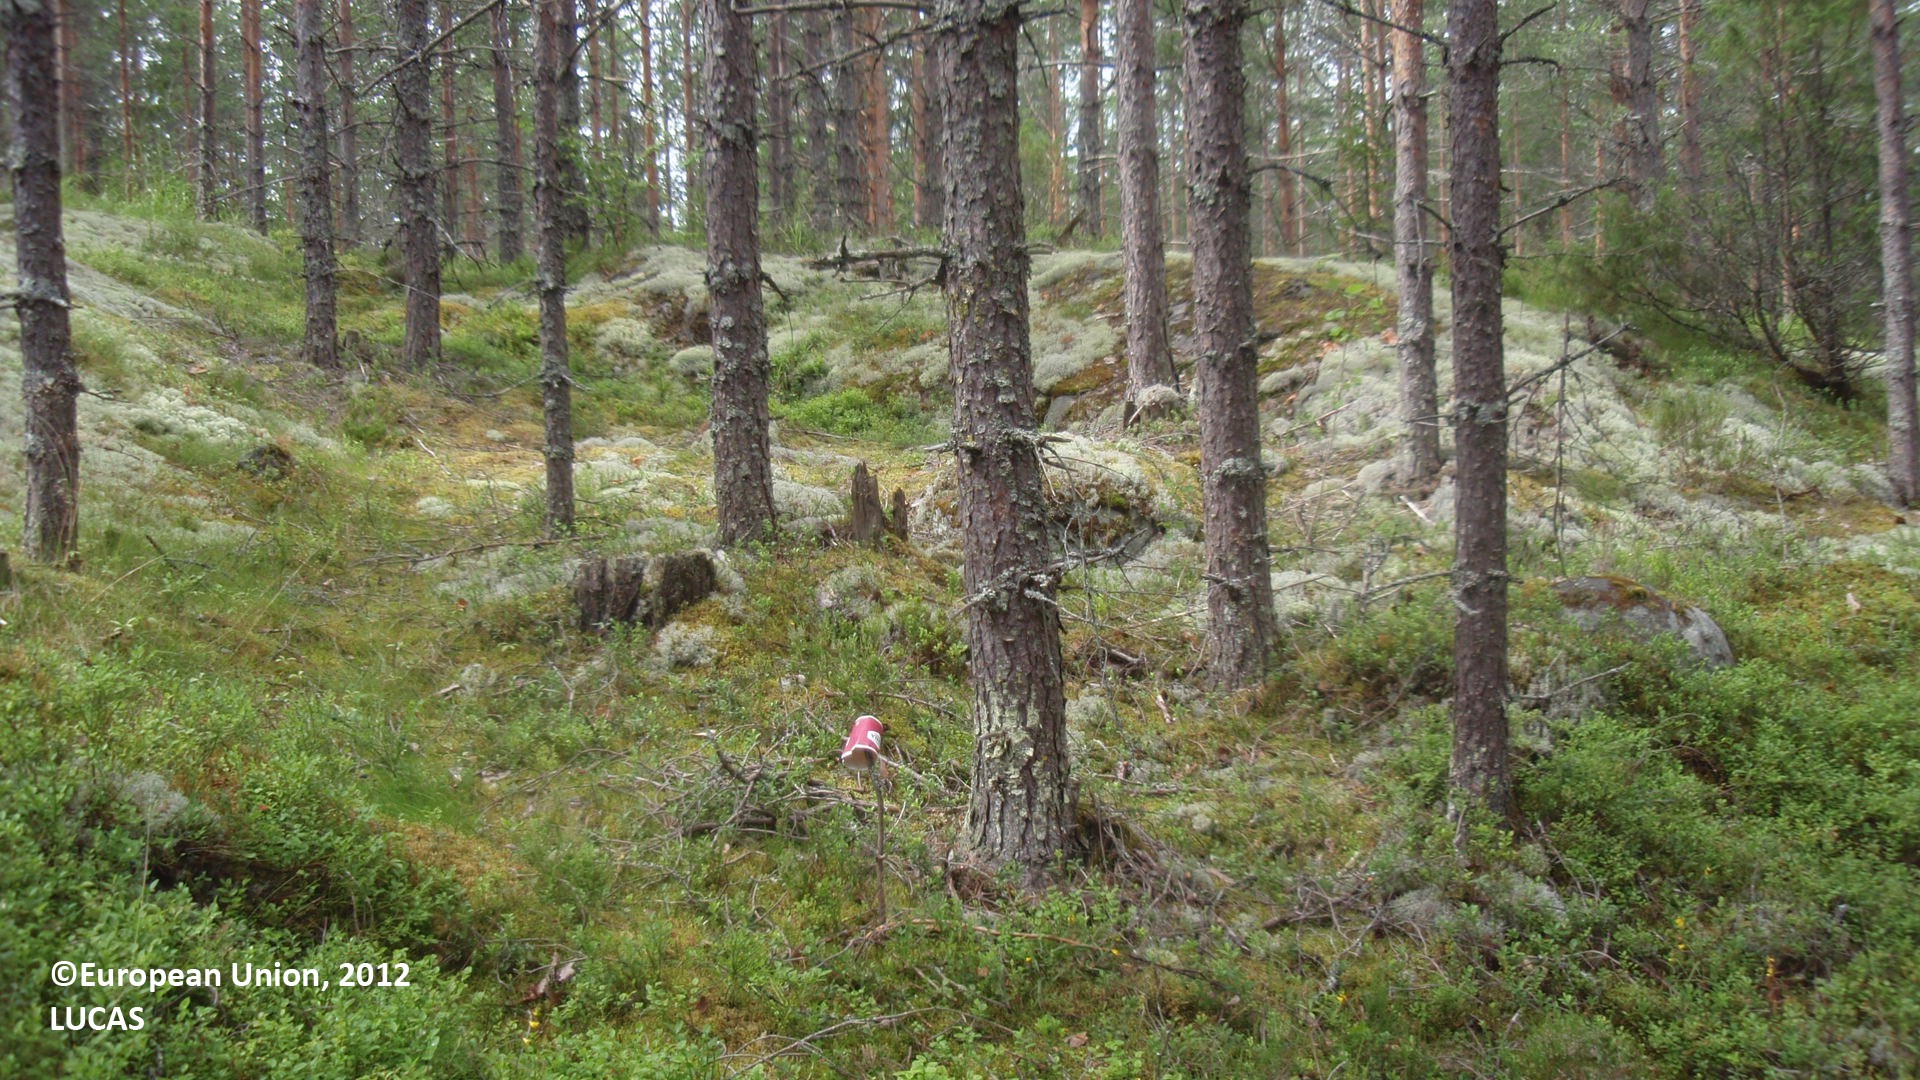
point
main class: Woodland
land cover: Pine dominated coniferous woodland
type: boreal forest
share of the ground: 50 - 75 %
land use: Forestry
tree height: > 5 m
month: July
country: FI
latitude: 61.4235
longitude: 28.4066
